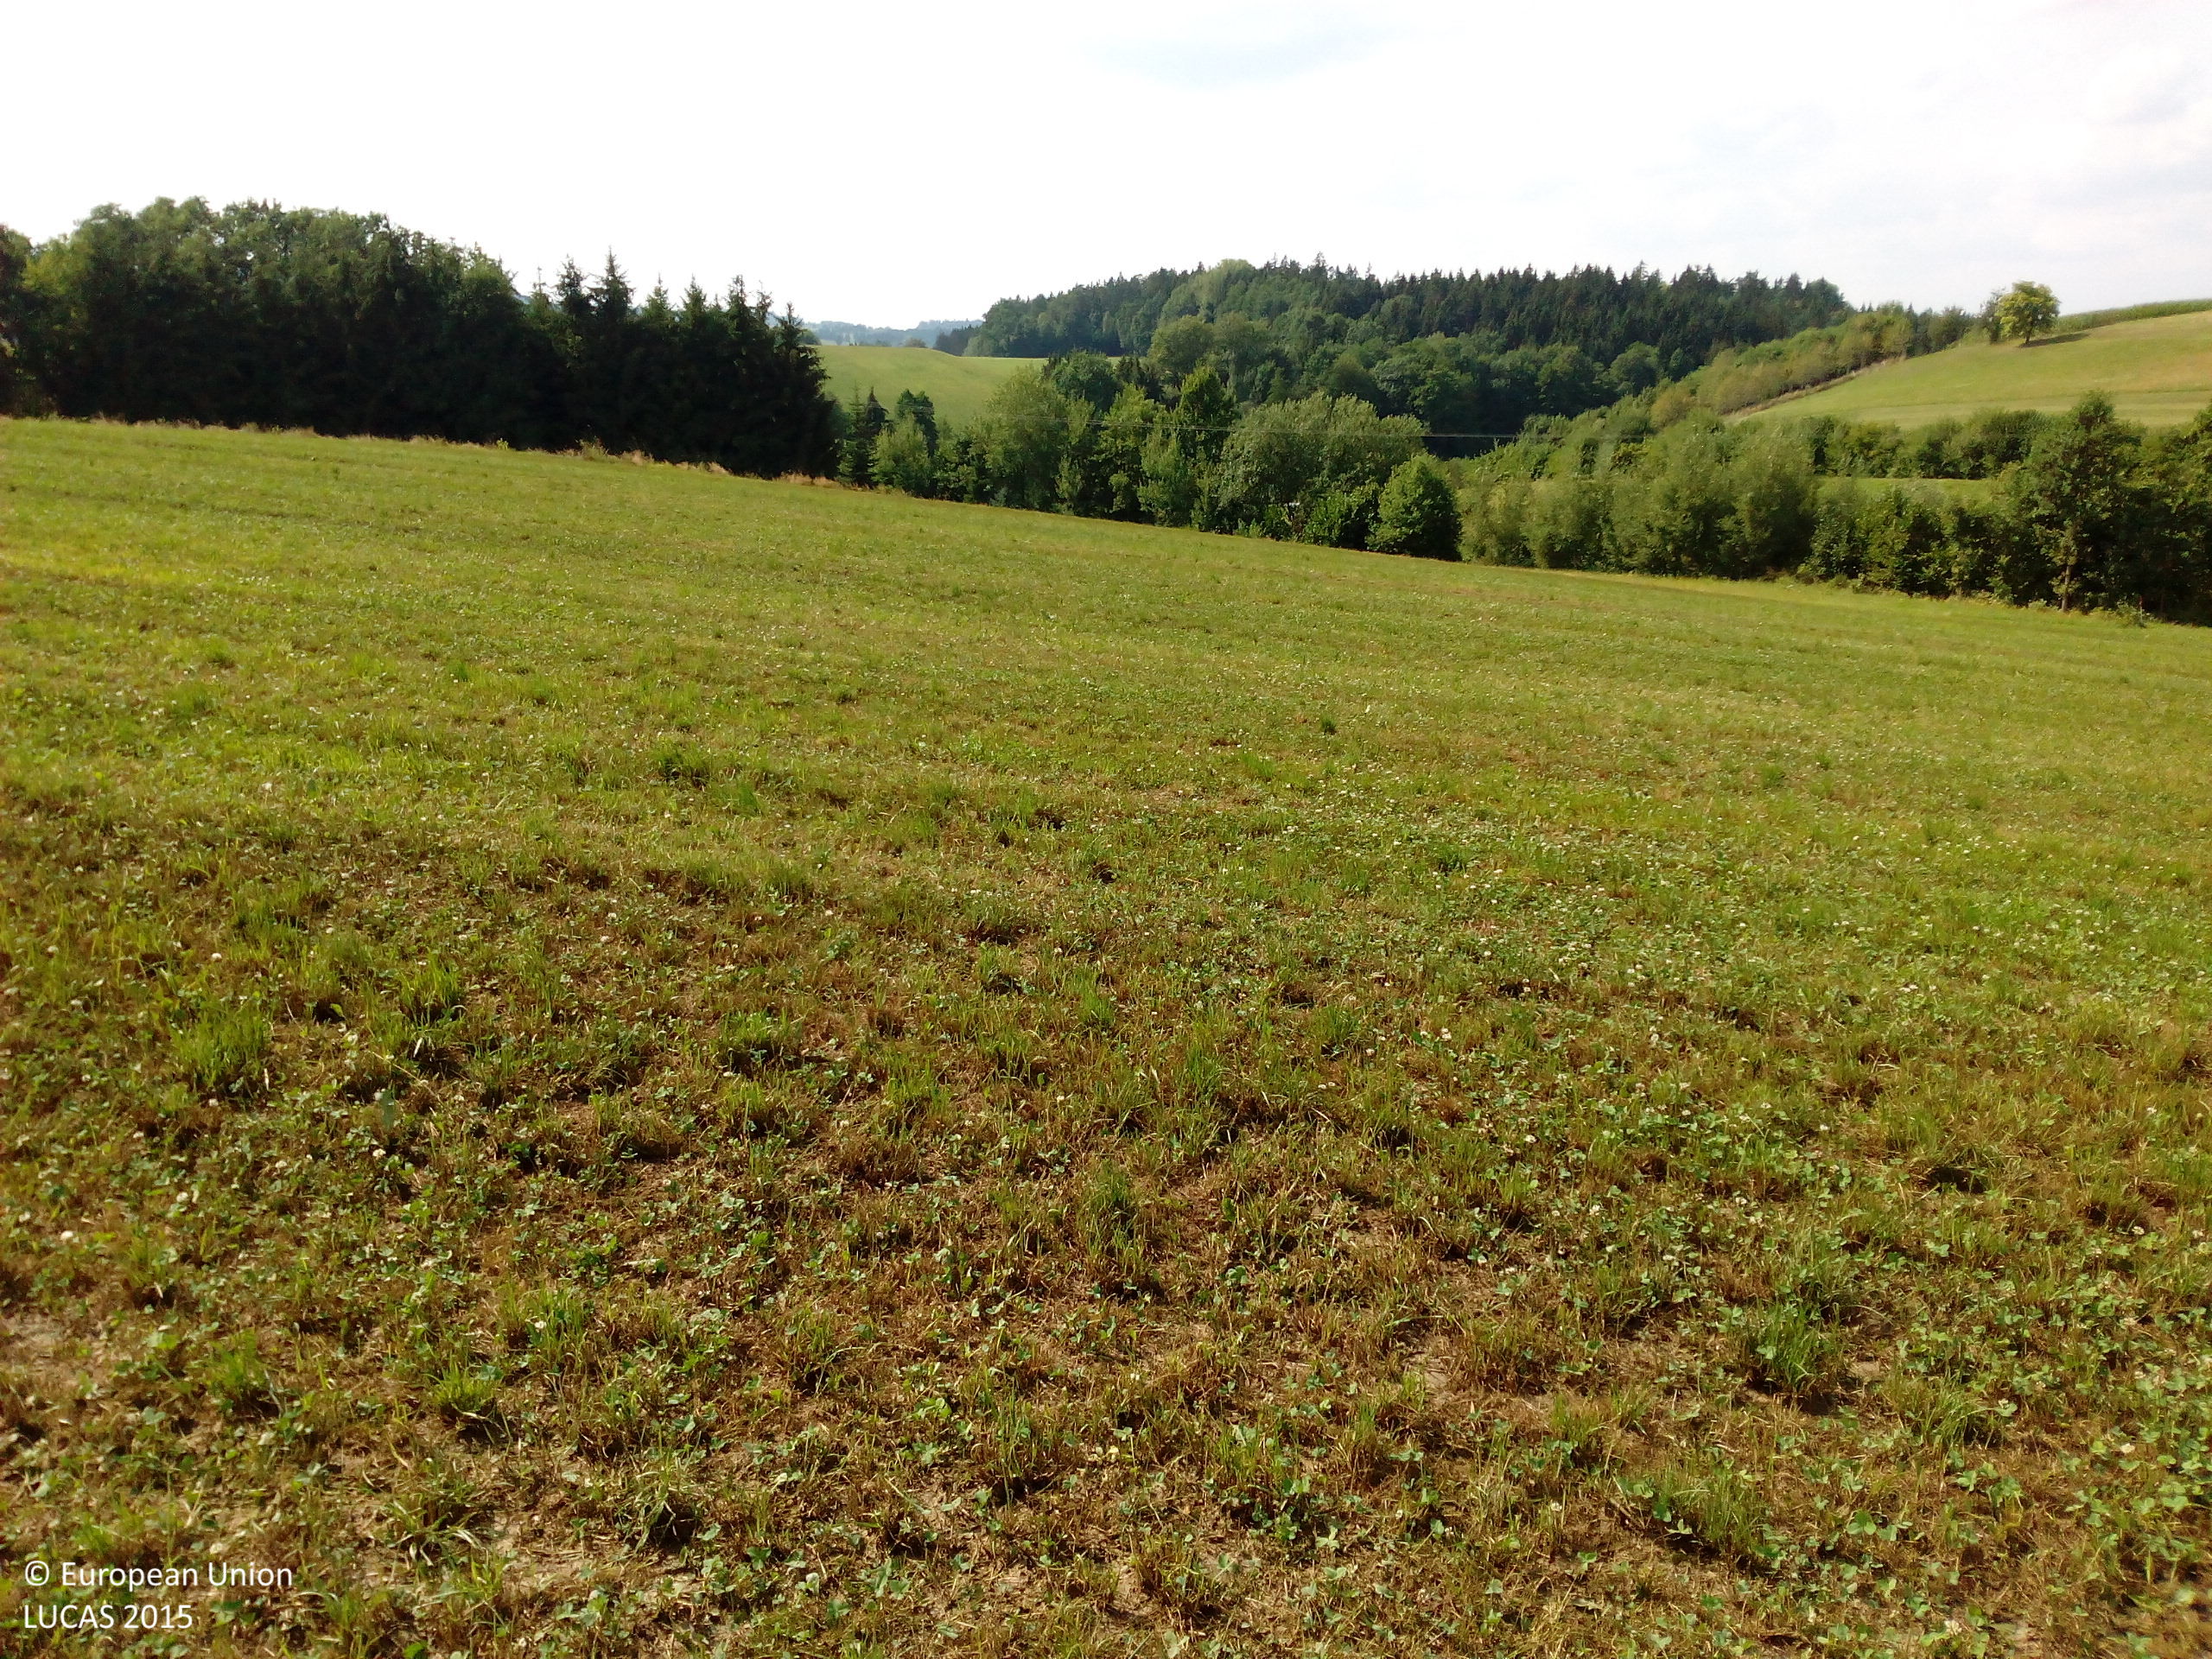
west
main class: Grassland
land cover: Grassland without tree/shrub cover
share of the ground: 50 - 75 %
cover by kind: herbaceous plants 60 %, unconsolidated bare surface 40 %
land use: Agriculture (excluding fallow land and kitchen gardens)
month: August
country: DE
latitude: 48.6596
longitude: 13.3258
